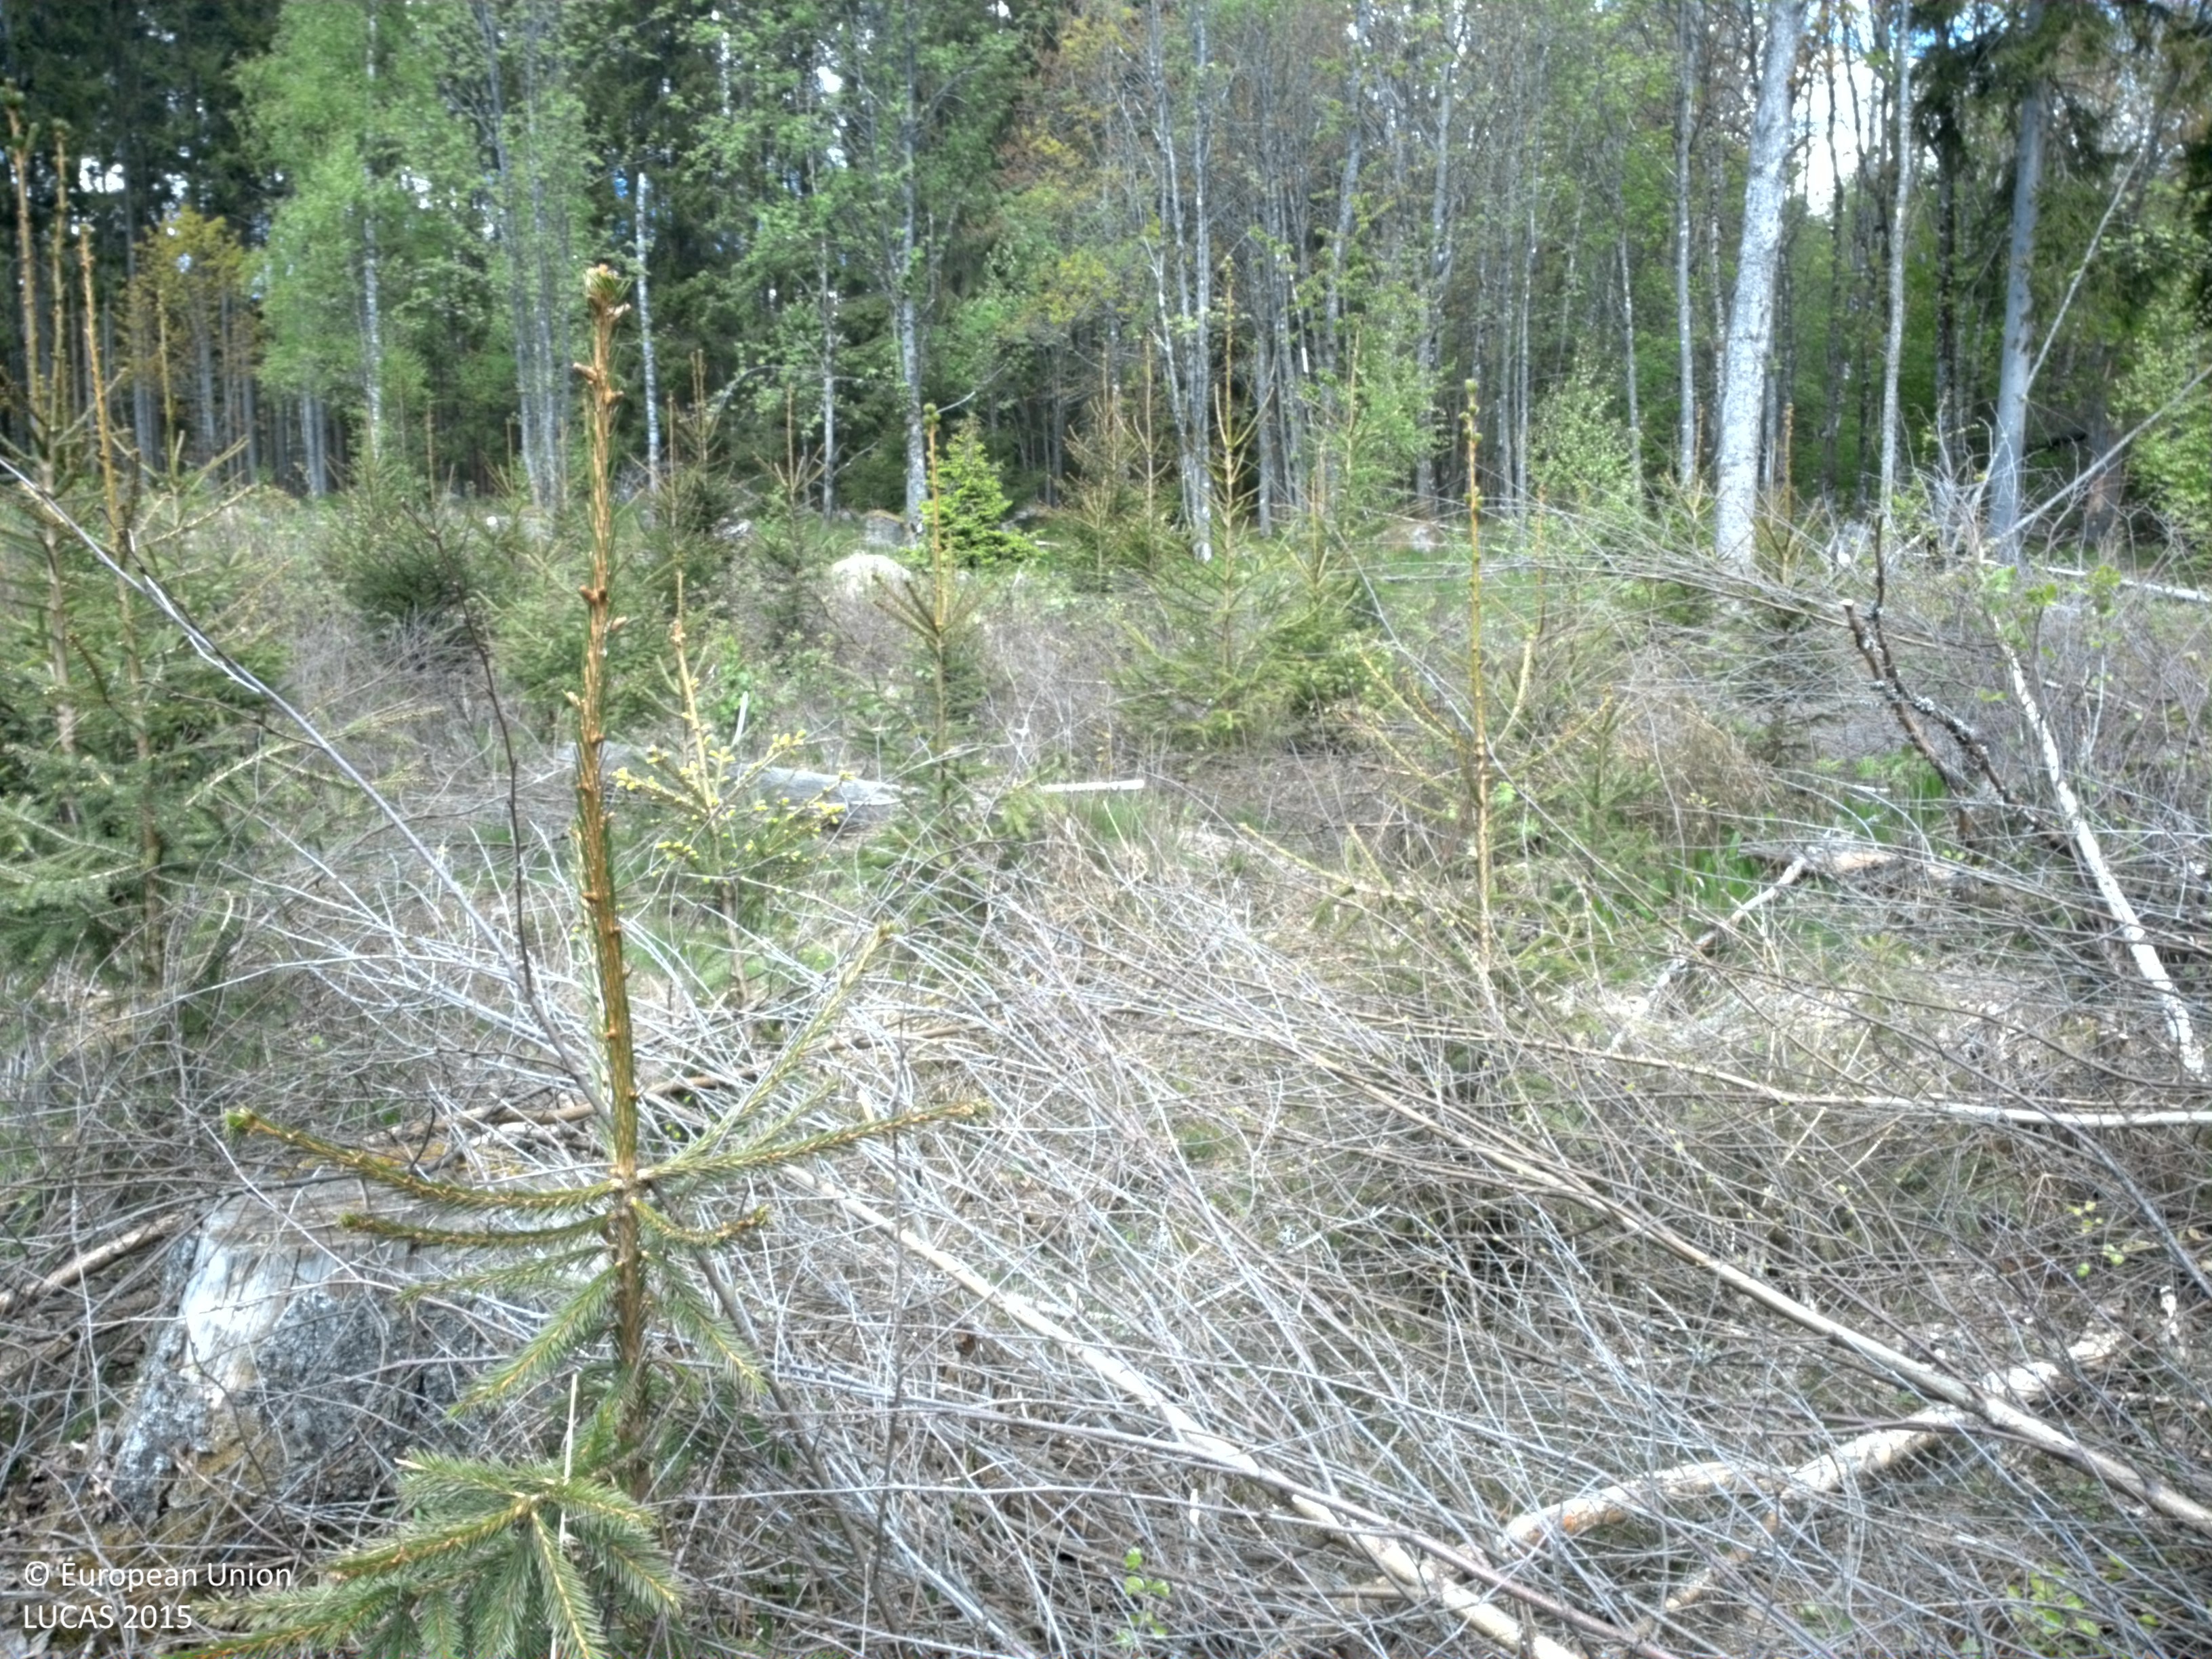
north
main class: Woodland
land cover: Spruce dominated mixed woodland
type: boreal forest
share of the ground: 25 - 50 %
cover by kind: coniferous forest trees 30 %, herbaceous plants 20 %, broadleaved forest trees 10 %, shrubs 10 %, unconsolidated bare surface 10 %
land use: Forestry
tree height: < 5 m
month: May
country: SE
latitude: 56.5296
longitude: 15.2824
